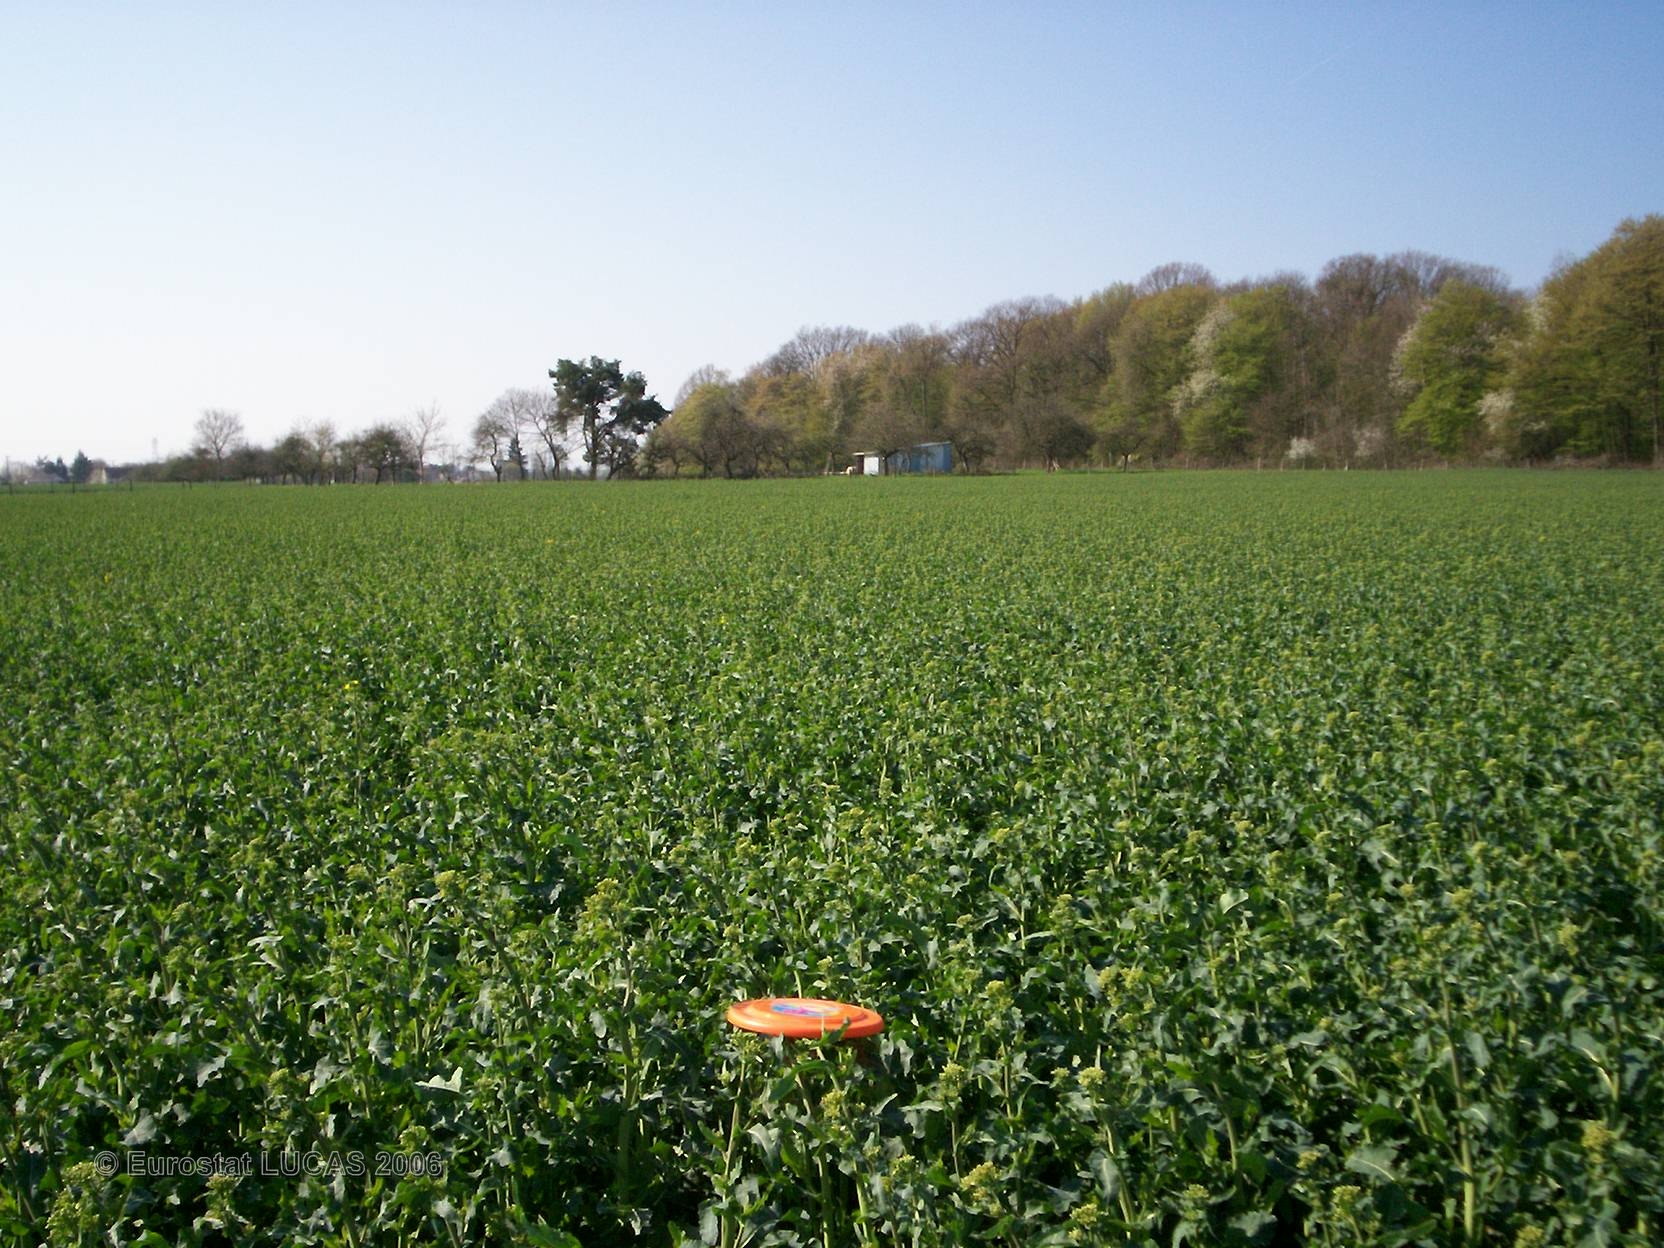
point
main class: Cropland
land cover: Rape and turnip rape
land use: Agriculture (excluding fallow land and kitchen gardens)
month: April
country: FR
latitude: 48.4081
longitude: 2.8720
